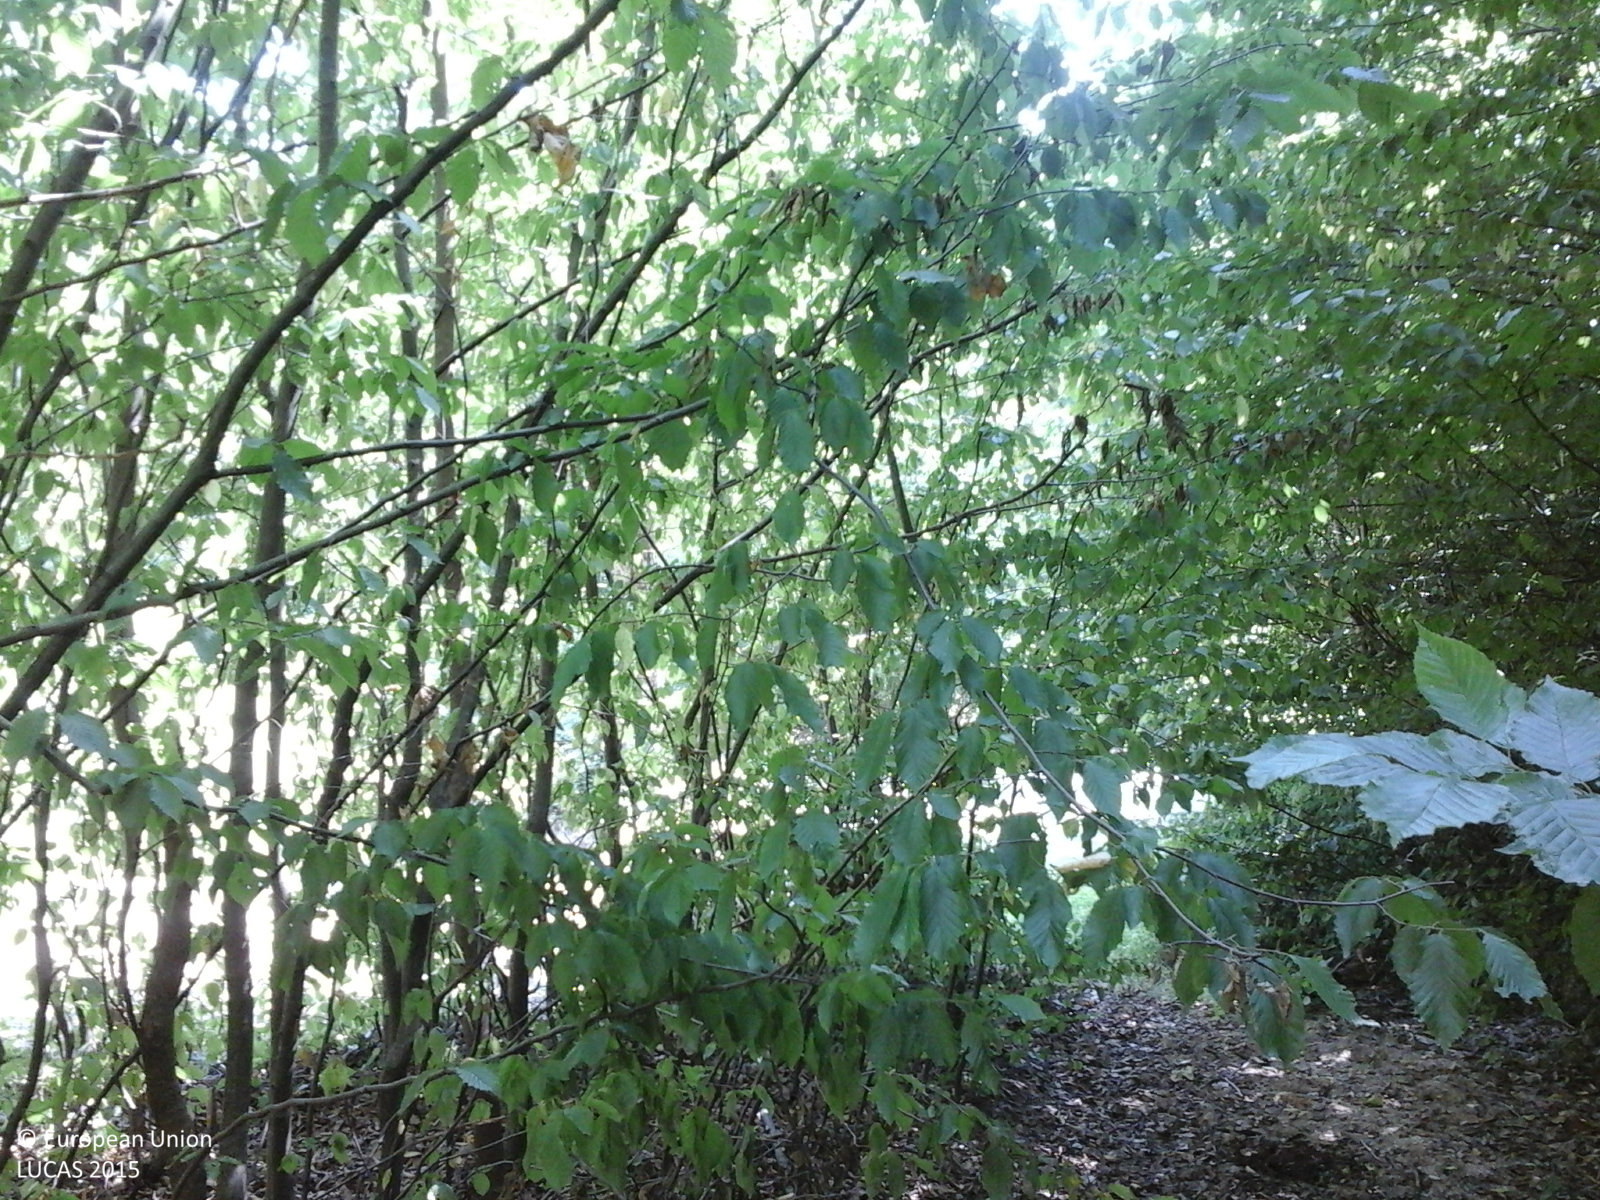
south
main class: Woodland
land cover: Broadleaved woodland
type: acidophilous oak and oak-birch forest
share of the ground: > 75 %
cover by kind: broadleaved forest trees 100 %
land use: Forestry
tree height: > 5 m
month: July
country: RO
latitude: 44.9066
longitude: 24.4487
